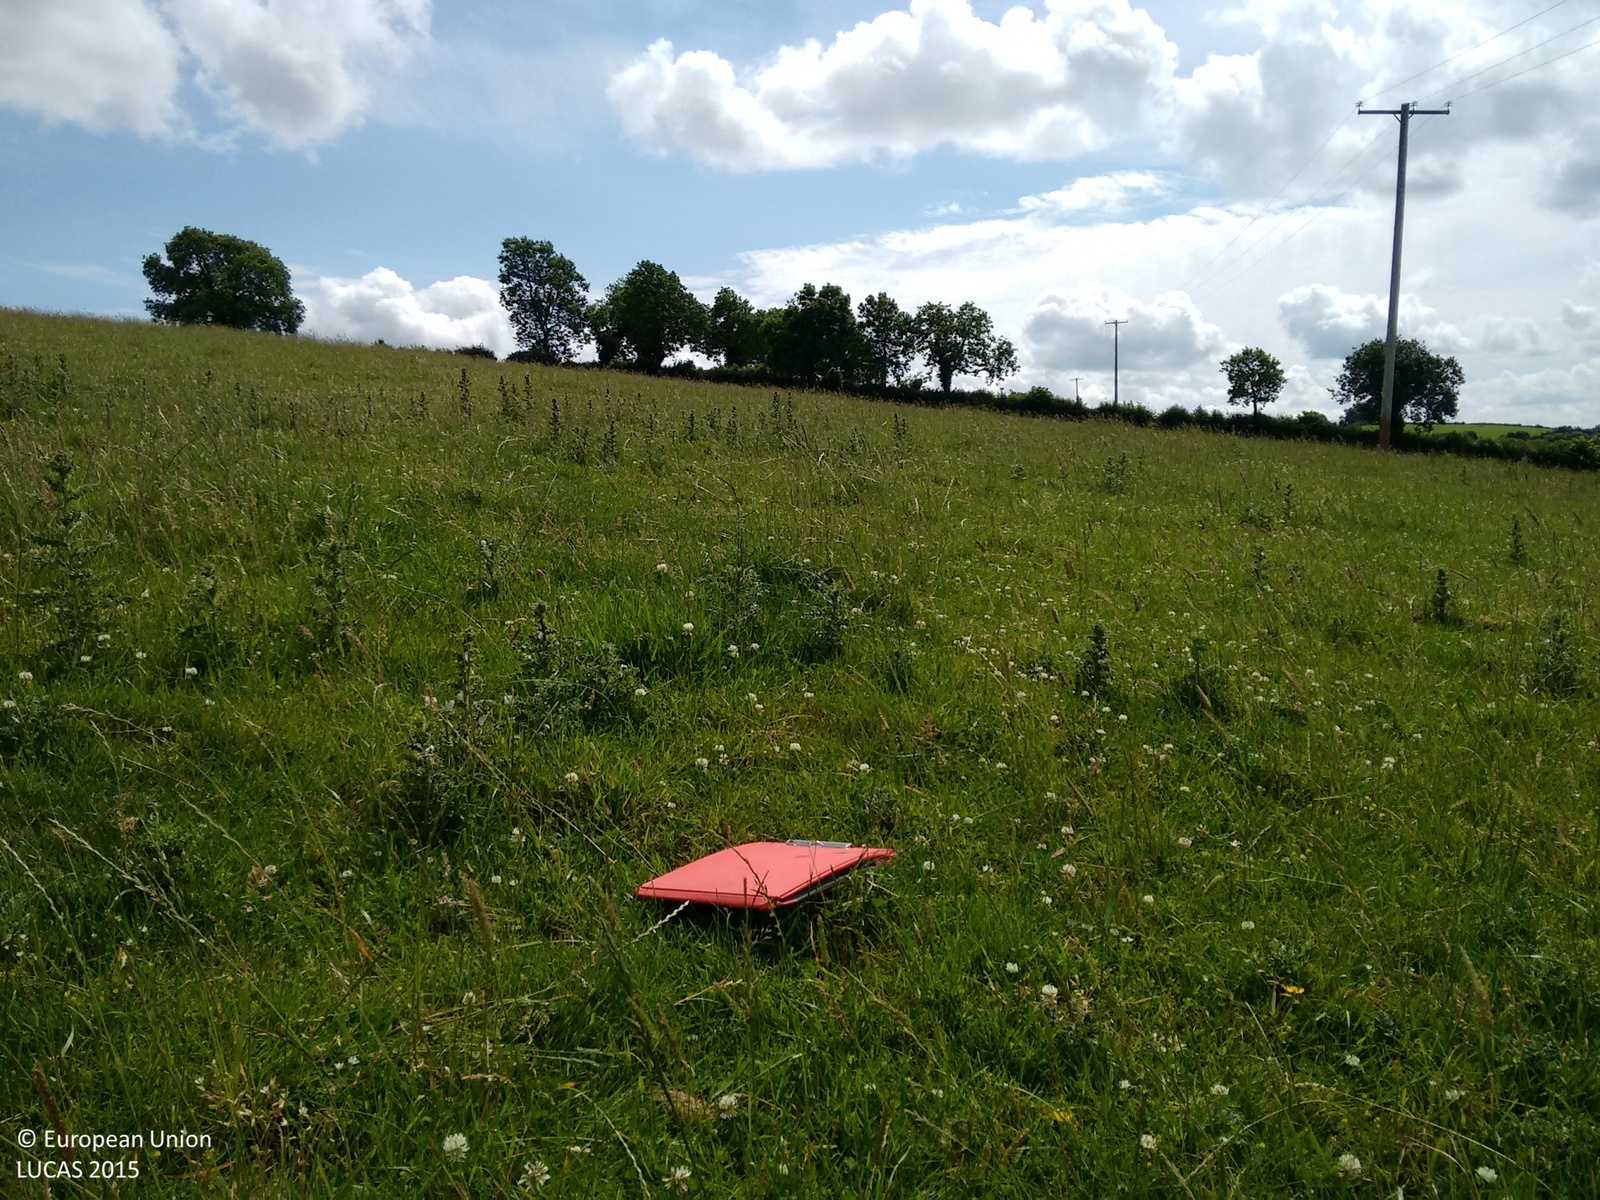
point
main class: Grassland
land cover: Grassland without tree/shrub cover
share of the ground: > 75 %
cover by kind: herbaceous plants 100 %
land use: Agriculture (excluding fallow land and kitchen gardens)
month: July
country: IE
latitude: 53.8852
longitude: -6.6997
